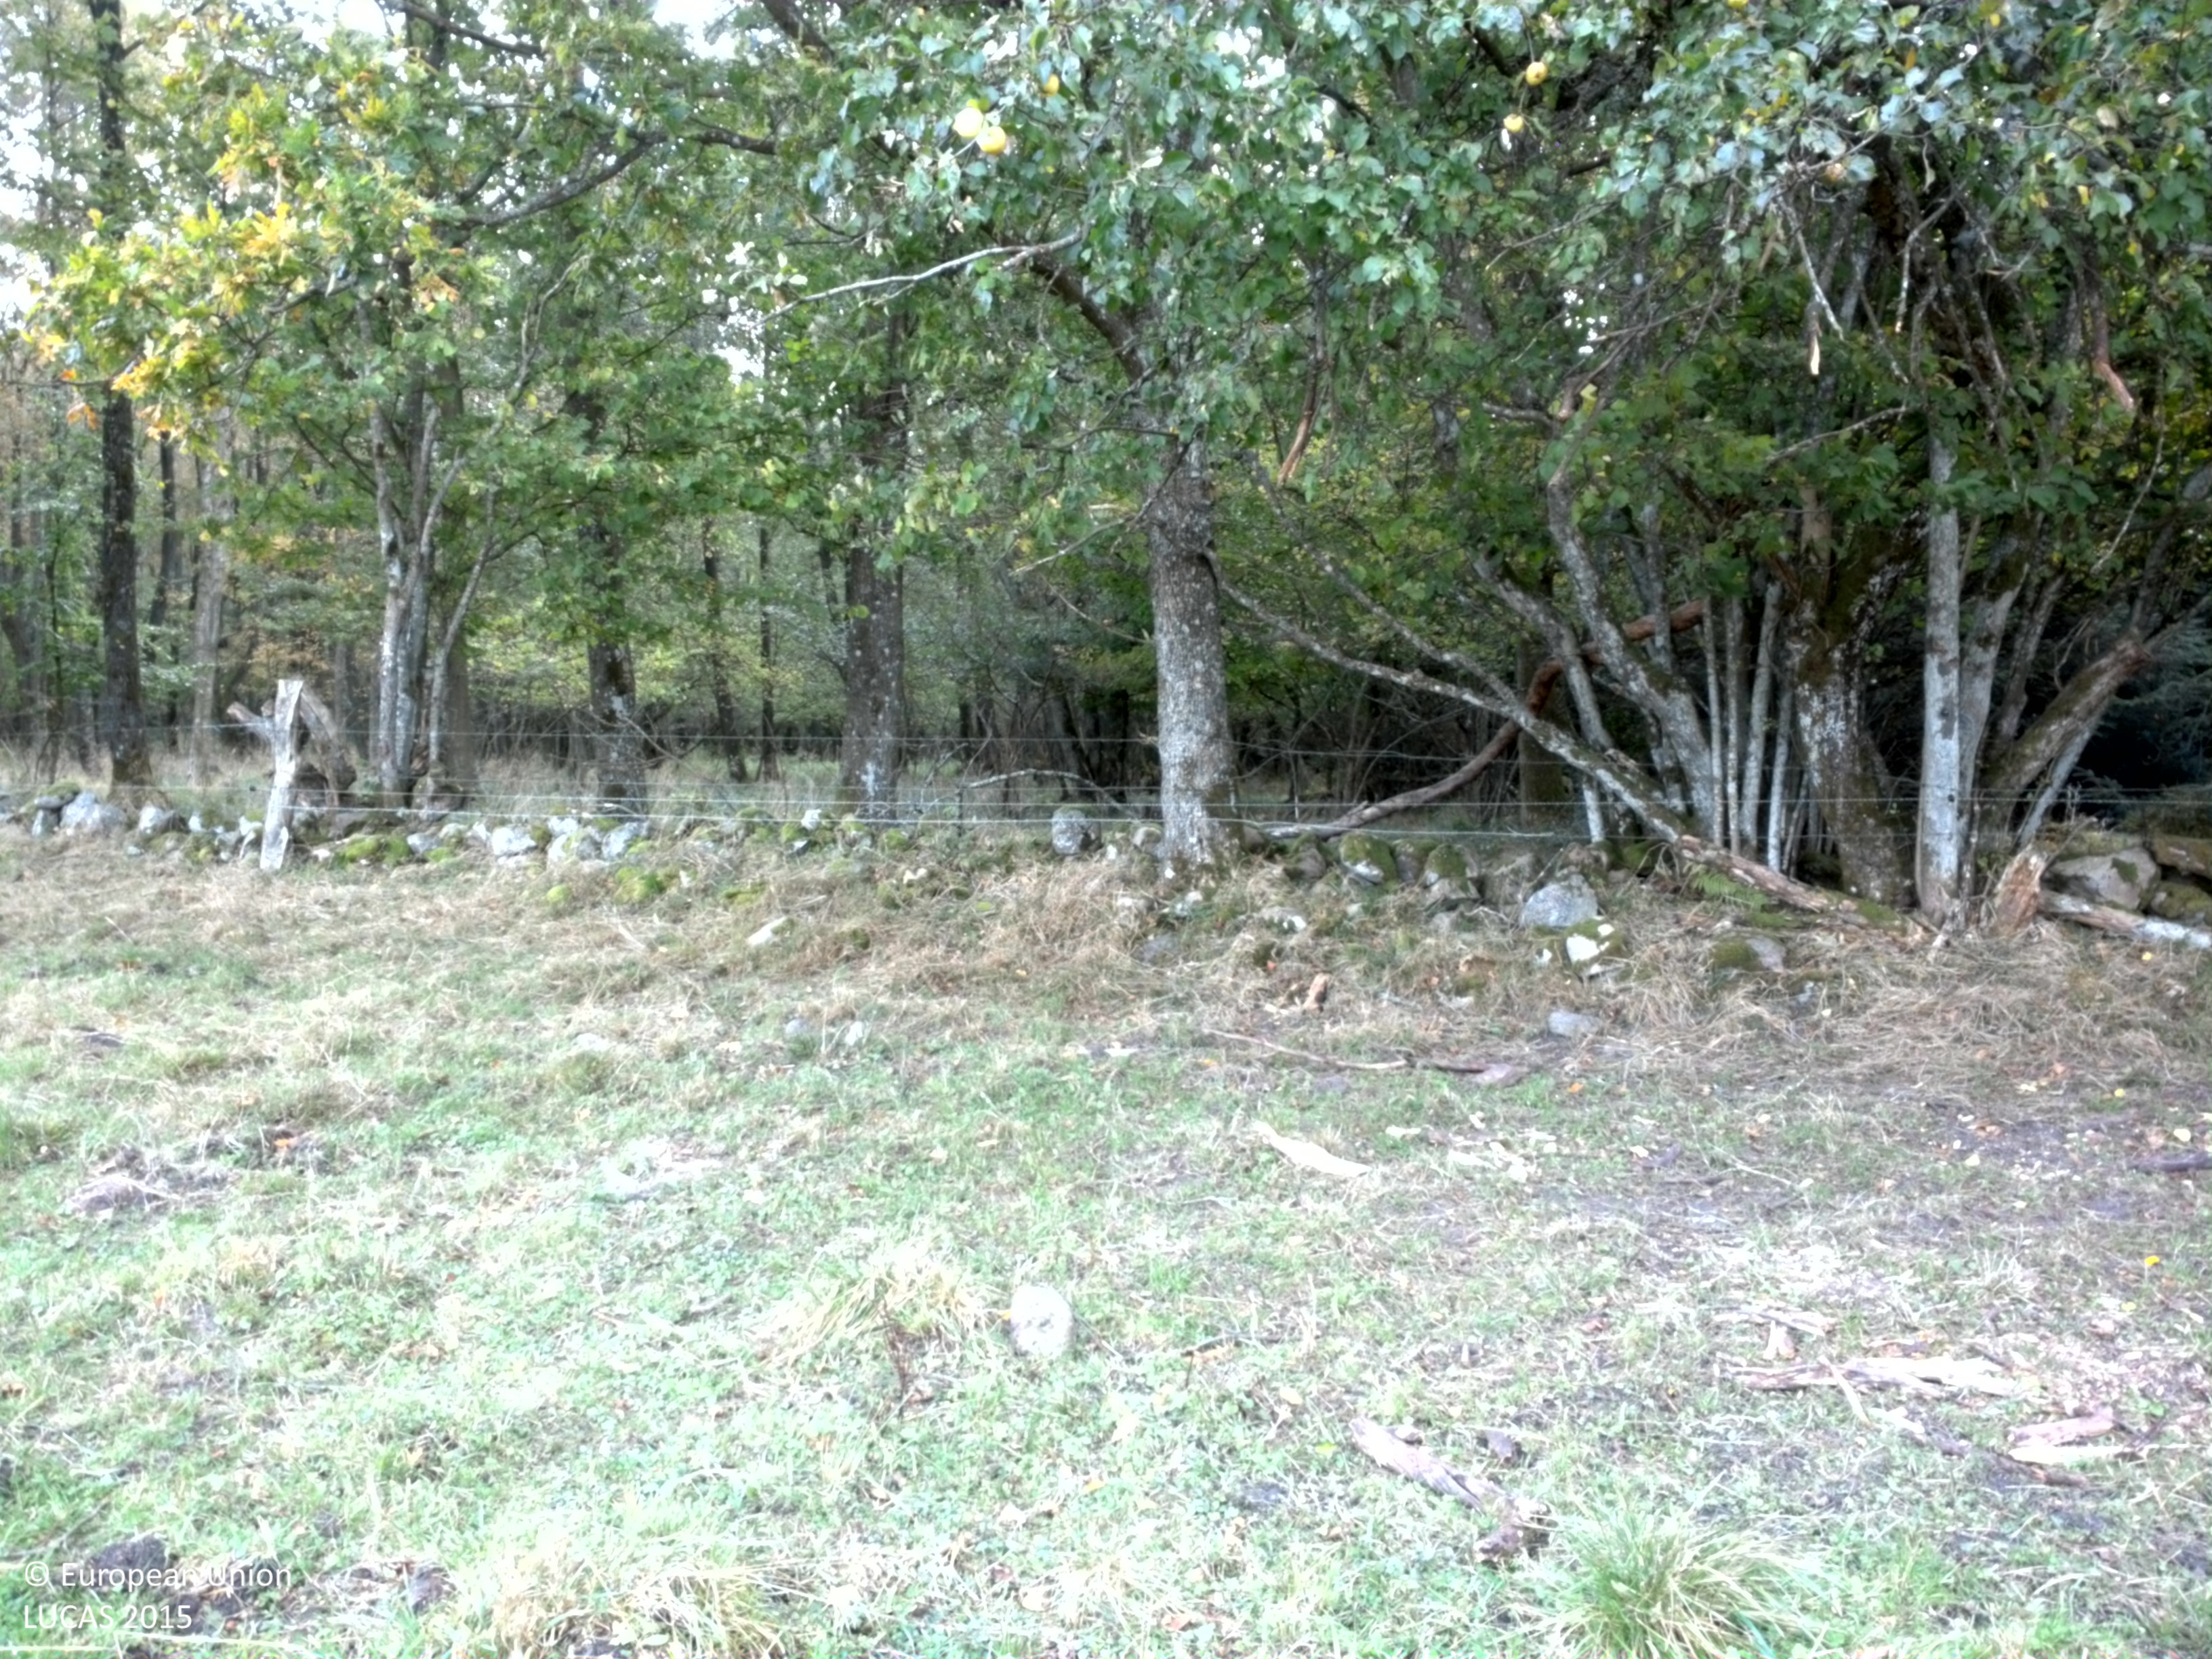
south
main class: Grassland
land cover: Grassland without tree/shrub cover
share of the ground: > 75 %
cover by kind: herbaceous plants 100 %
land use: Agriculture (excluding fallow land and kitchen gardens)
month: October
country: SE
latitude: 55.6918
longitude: 14.0549
